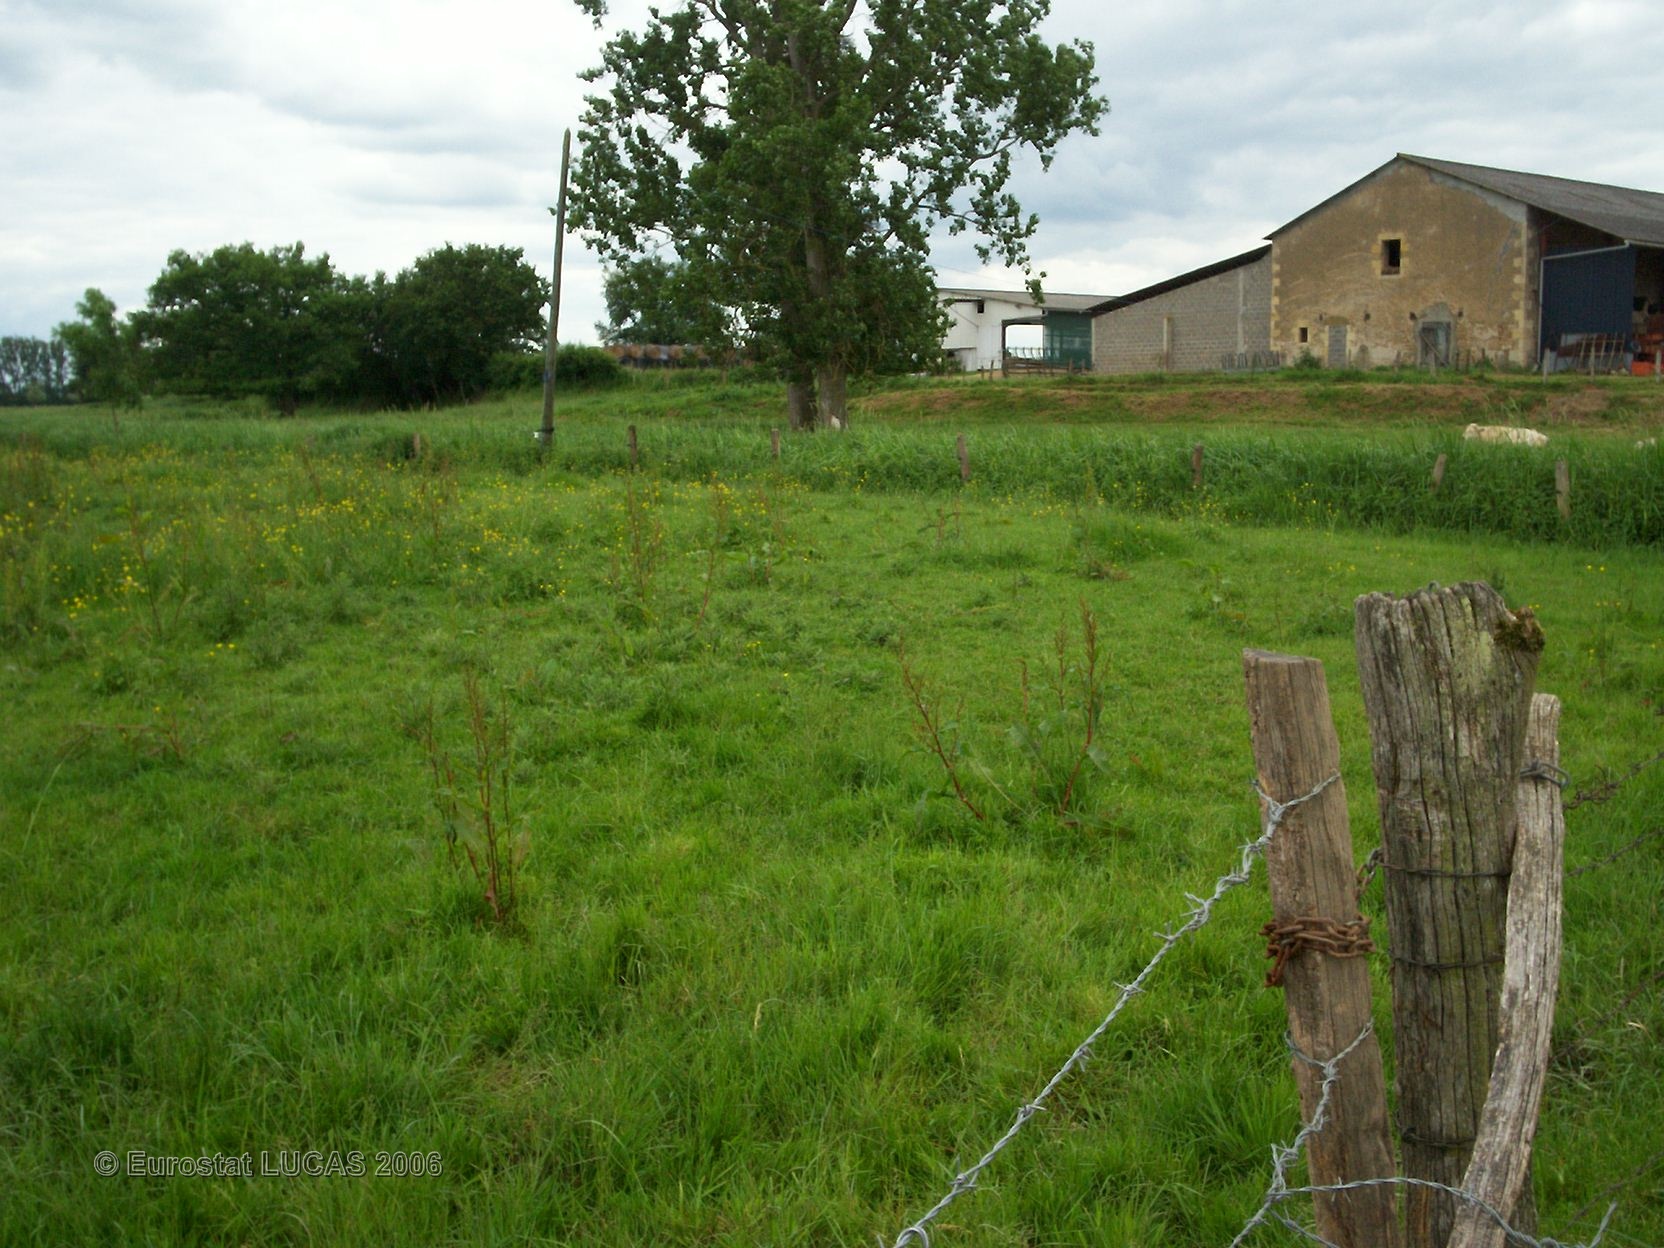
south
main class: Grassland
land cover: Grassland without tree/shrub cover
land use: Agriculture (excluding fallow land and kitchen gardens)
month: May
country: FR
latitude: 46.8664
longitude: 3.0566
